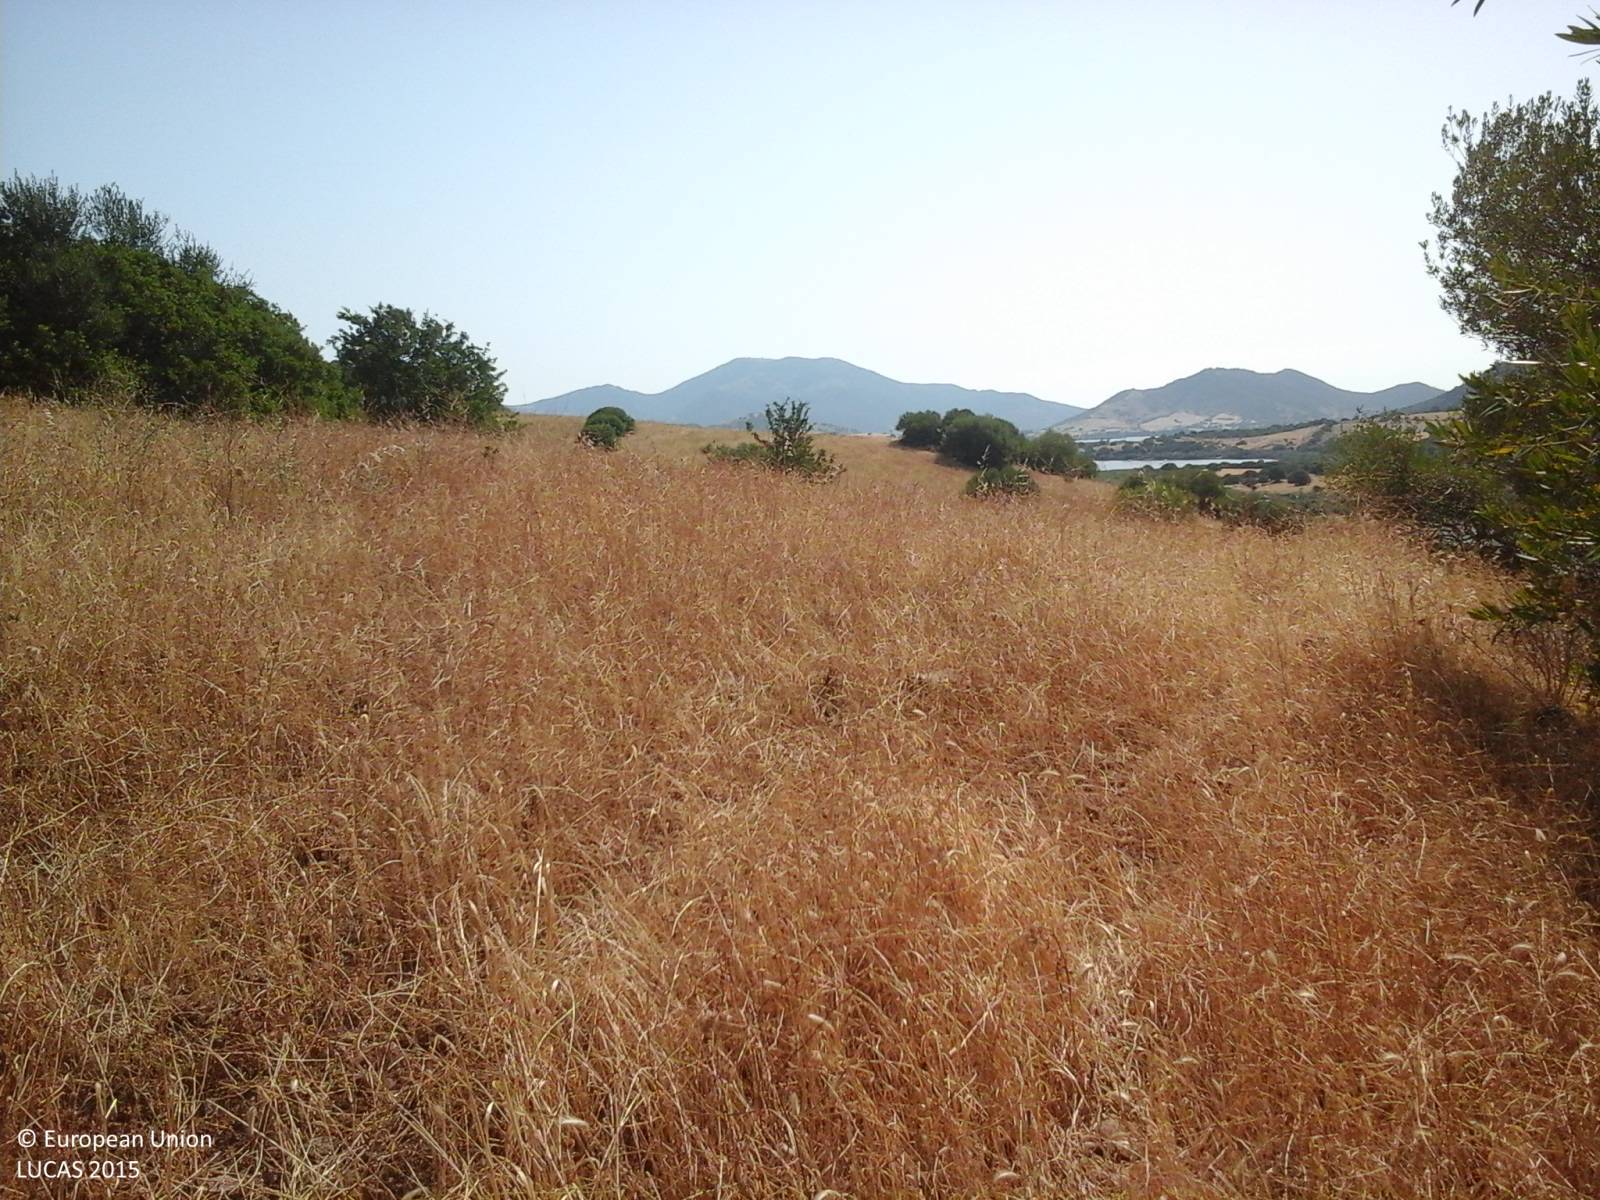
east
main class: Woodland
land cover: Broadleaved woodland
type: broadleaved evergreen forest
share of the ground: > 75 %
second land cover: Temporary grasslands
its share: > 75 %
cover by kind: broadleaved forest trees 95 %, herbaceous plants 5 %
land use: Forestry
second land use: Agriculture (excluding fallow land and kitchen gardens)
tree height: > 5 m
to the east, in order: Broadleaved woodland; Temporary grasslands; Shrubland without tree cover; Temporary grasslands; Broadleaved woodland; Arable land (only in case pi); Broadleaved woodland
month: July
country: IT
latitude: 40.6283
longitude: 9.5647
